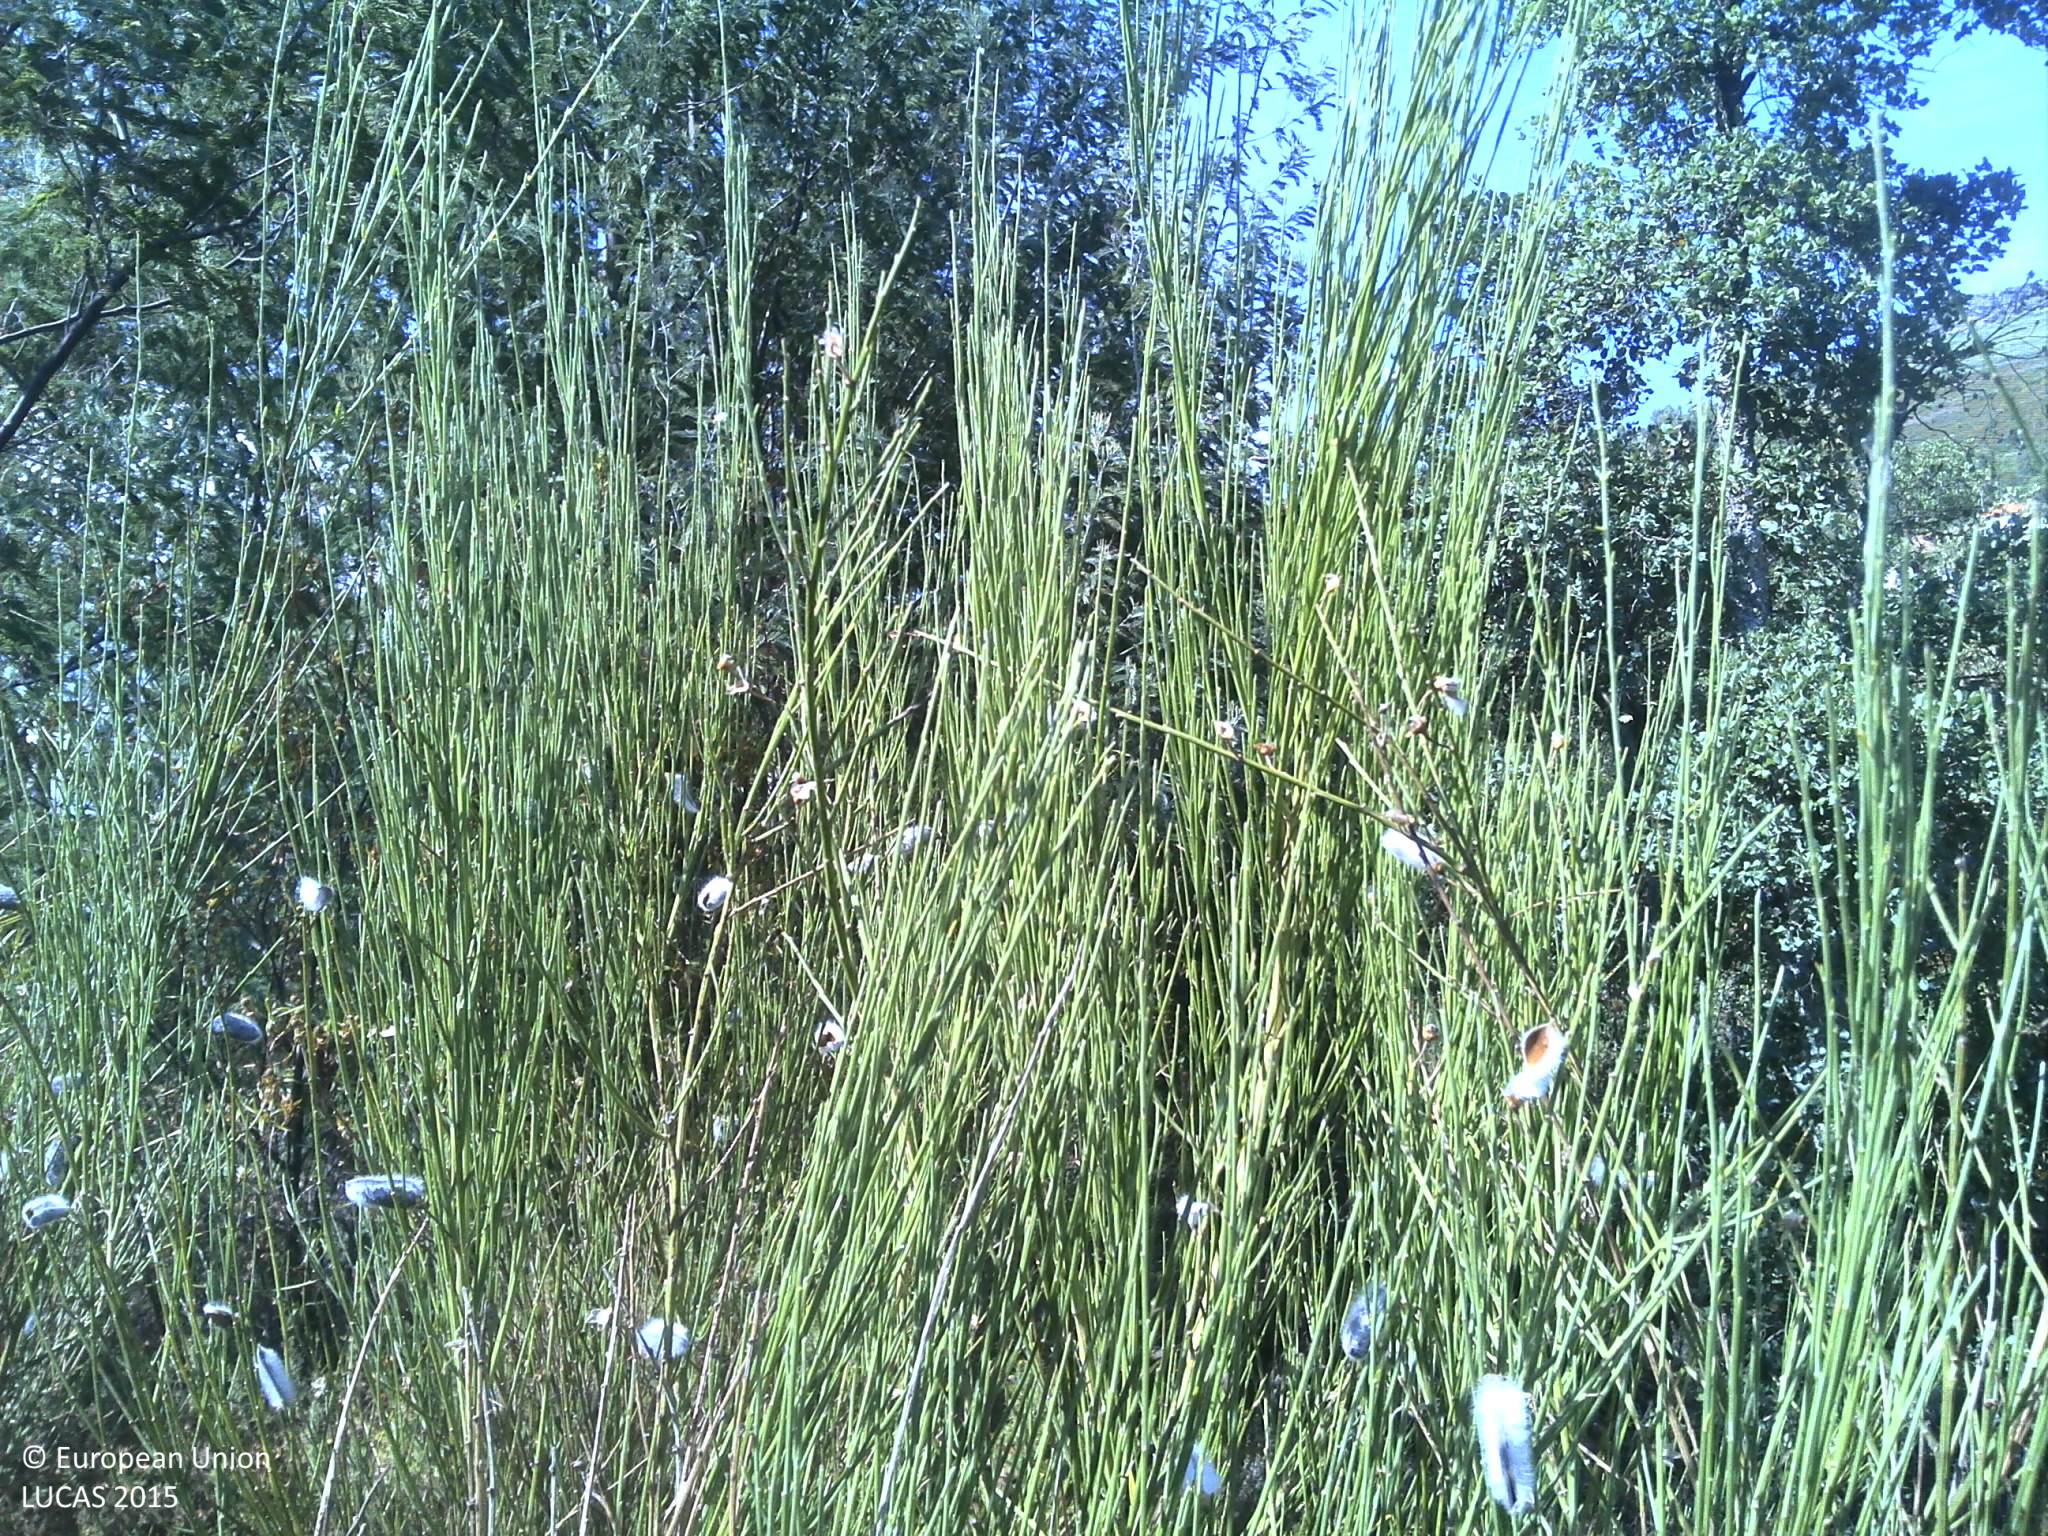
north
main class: Shrubland
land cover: Shrubland with sparse tree cover
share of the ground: > 75 %
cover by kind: shrubs 85 %, unconsolidated bare surface 10 %, coniferous forest trees 5 %
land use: Semi-natural and natural areas not in use
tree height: > 5 m
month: July
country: PT
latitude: 40.0873
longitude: -7.8818
